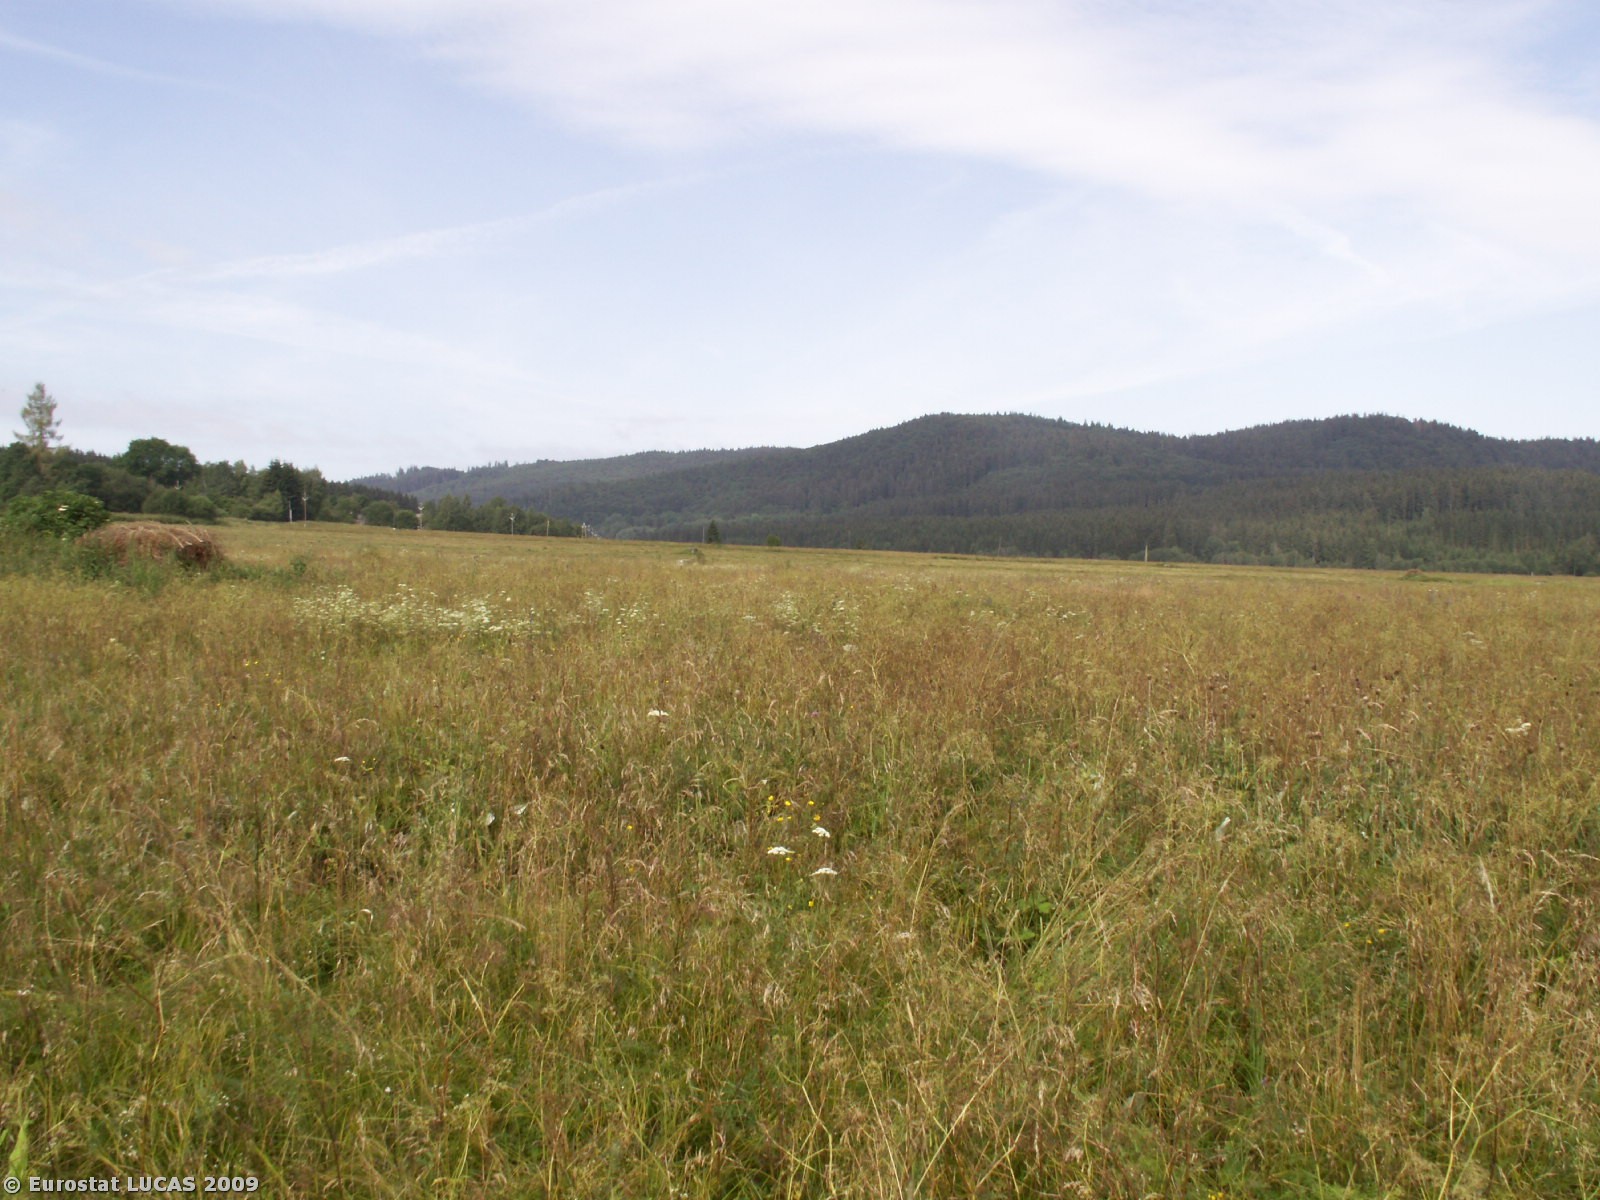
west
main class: Grassland
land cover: Grassland without tree/shrub cover
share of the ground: > 75 %
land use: Fallow land
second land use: Nature reserves
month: July
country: CZ
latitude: 48.8954
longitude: 13.8331
